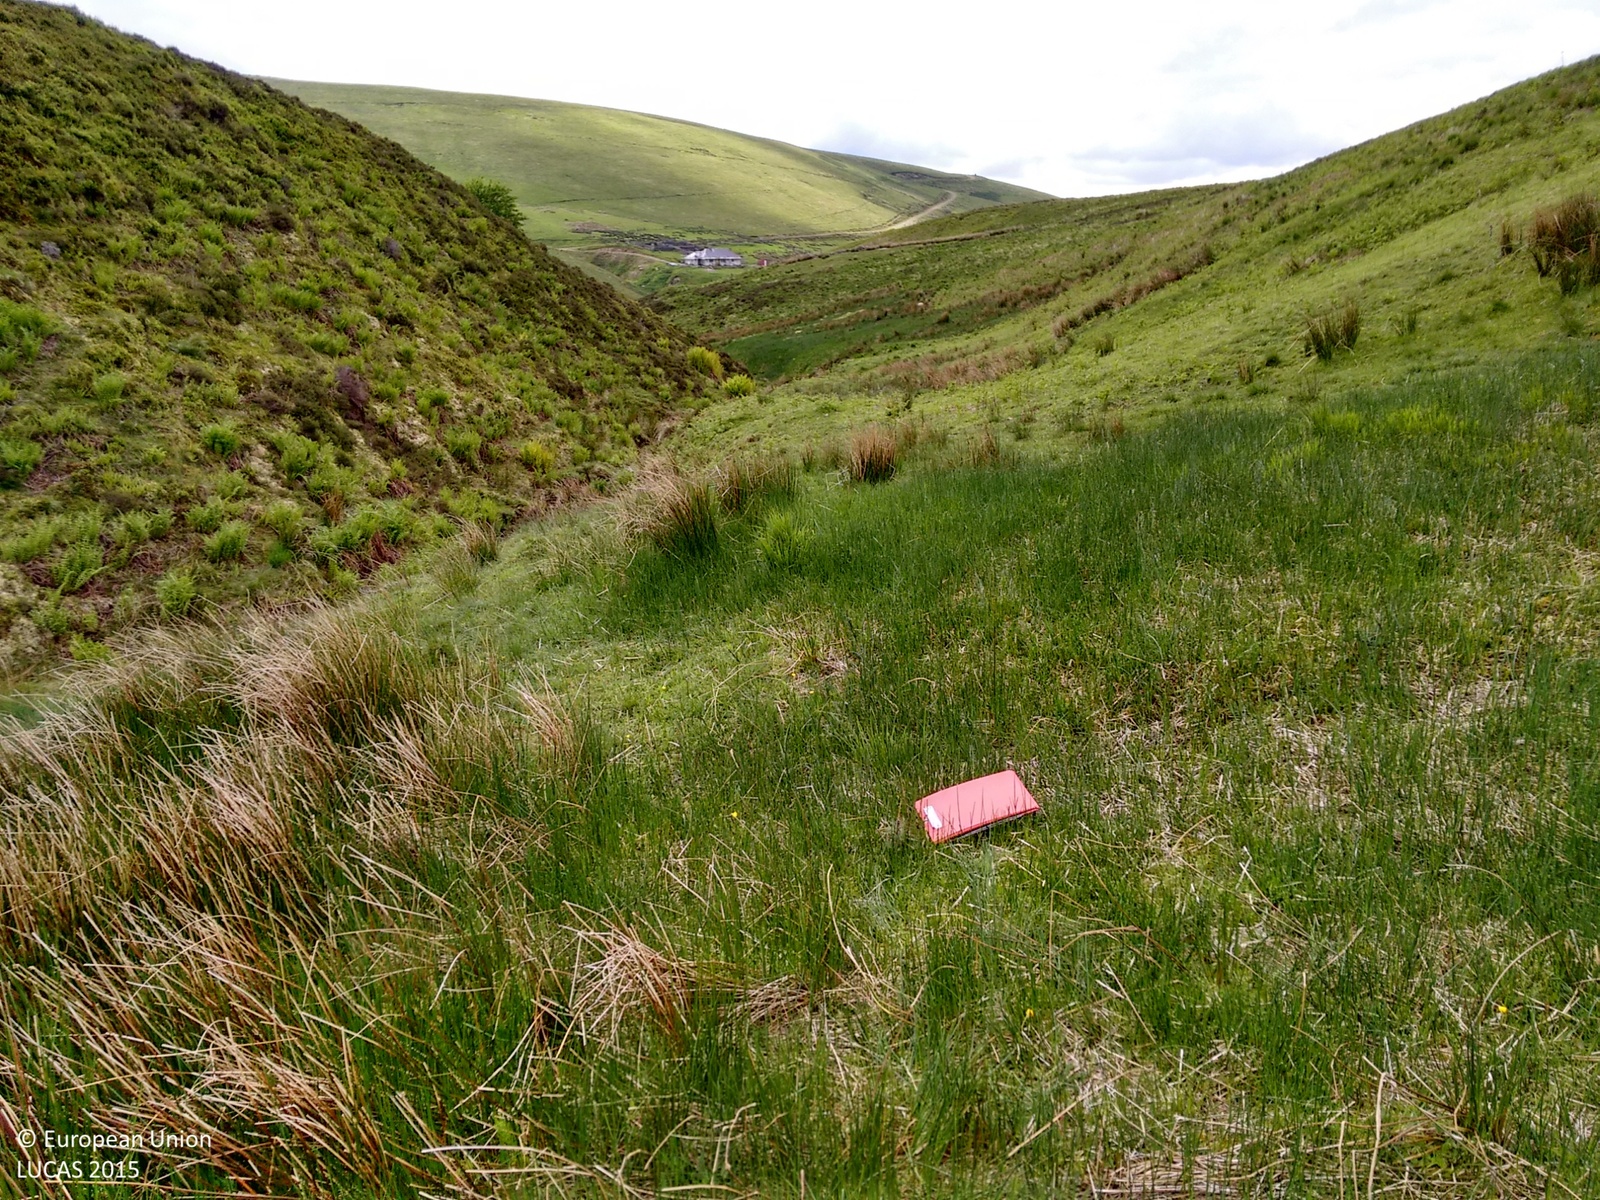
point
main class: Grassland
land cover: Grassland without tree/shrub cover
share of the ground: > 75 %
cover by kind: herbaceous plants 90 %, shrubs 5 %, lichens and mosses 5 %
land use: Agriculture (excluding fallow land and kitchen gardens)
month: June
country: GB
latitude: 55.4174
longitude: -3.8137
